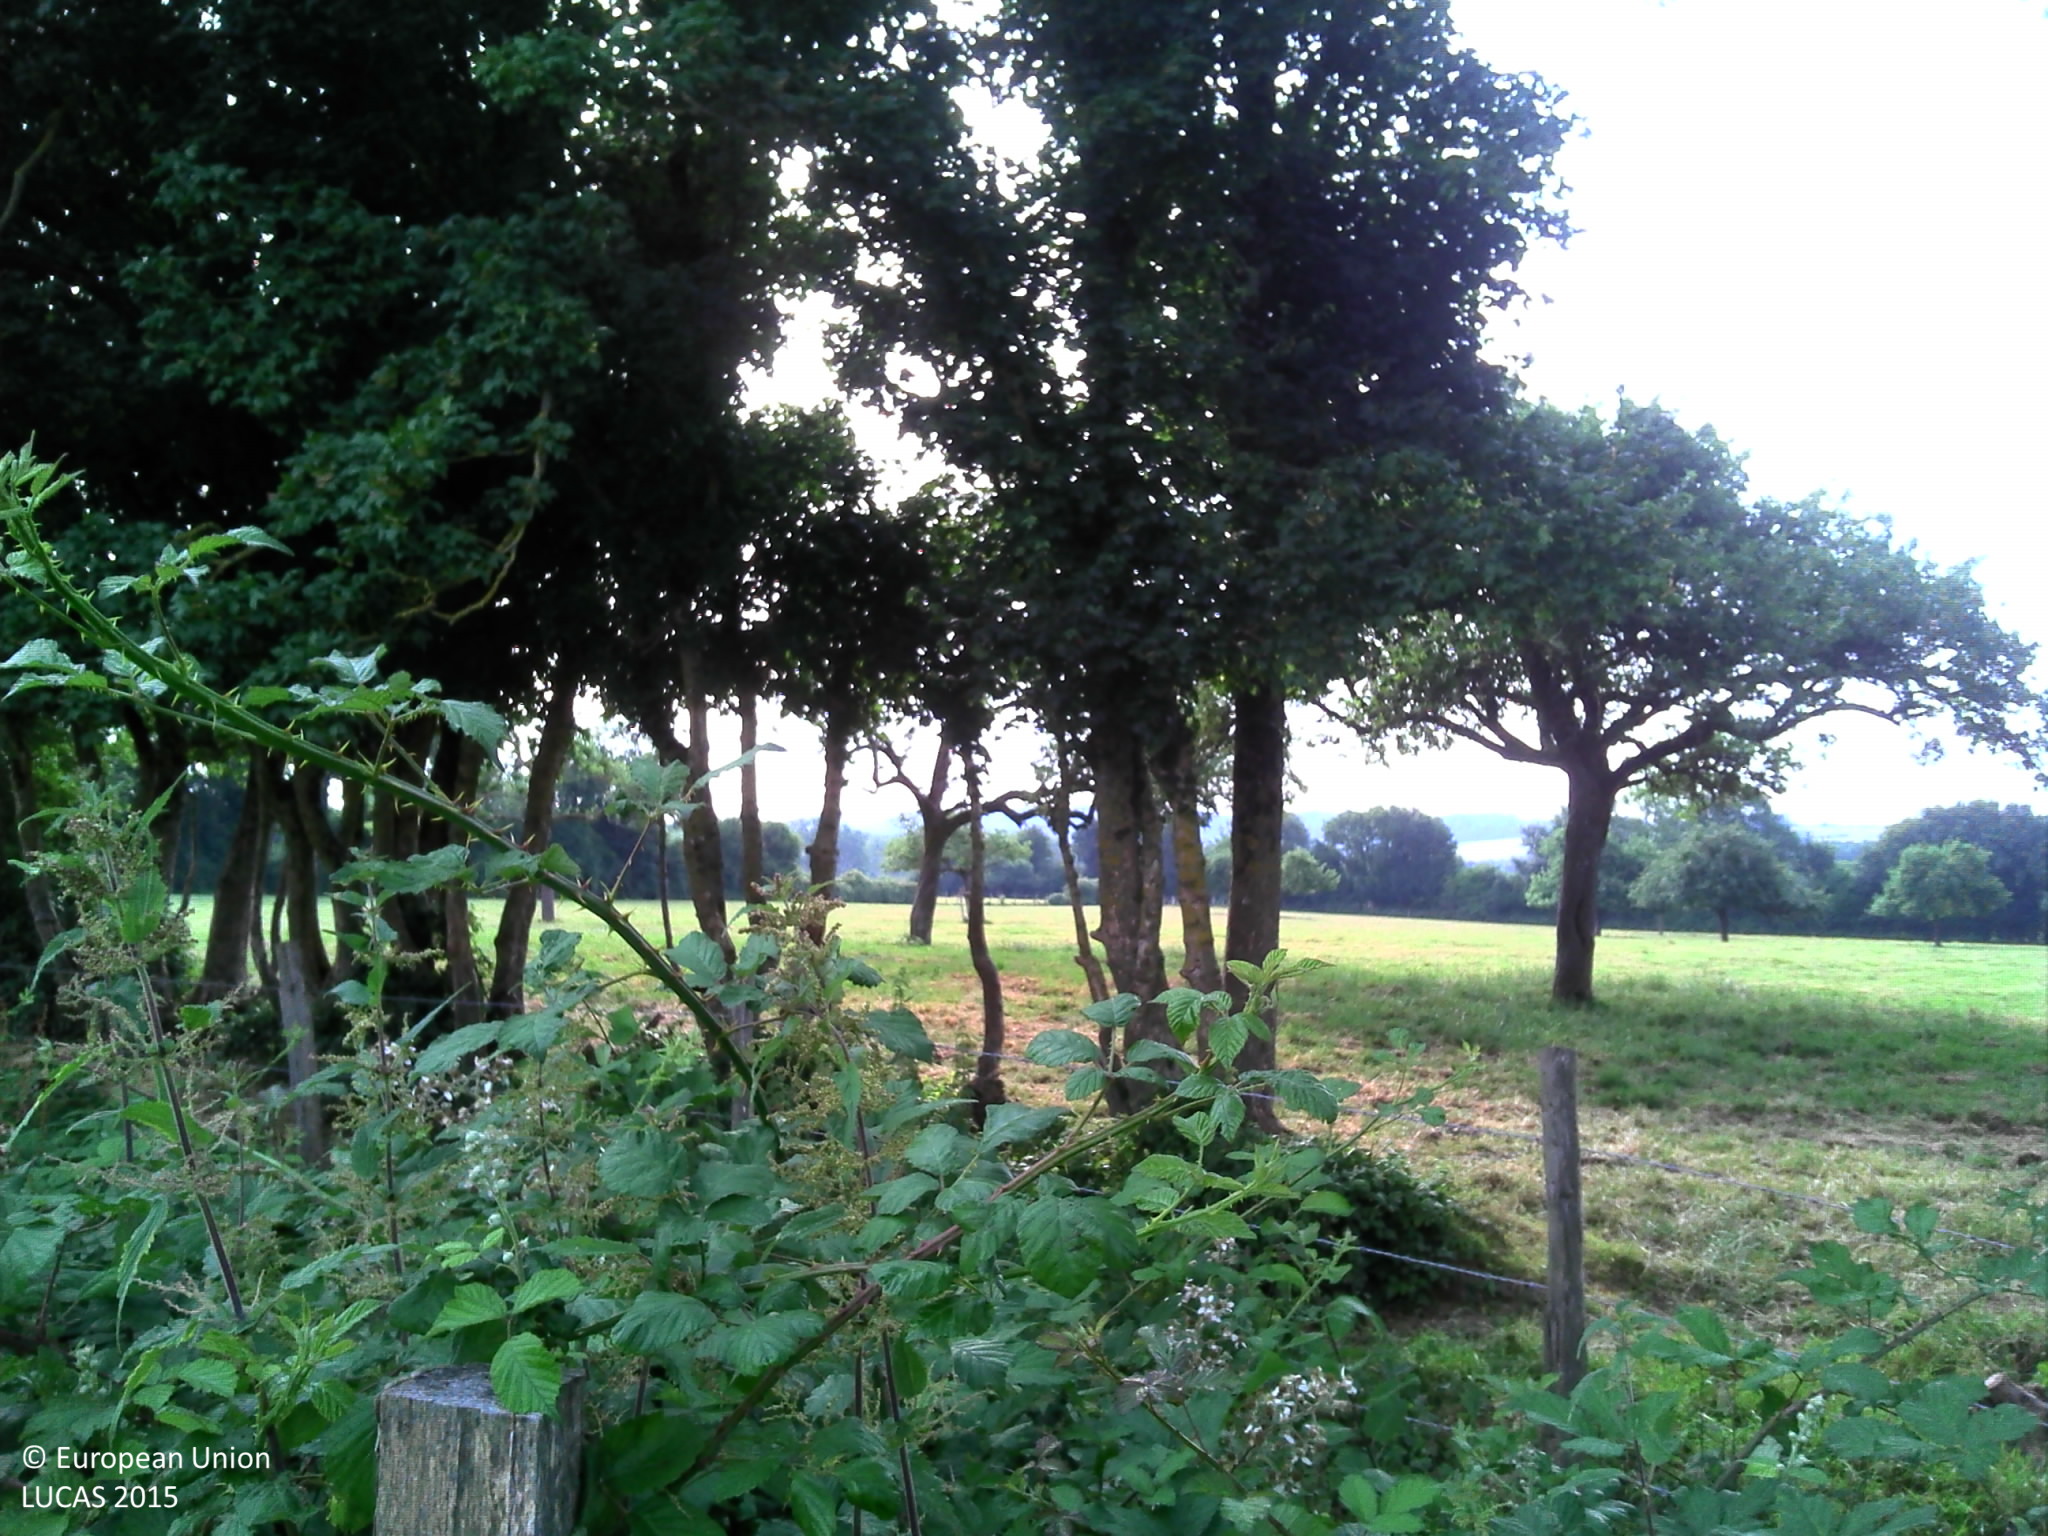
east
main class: Cropland
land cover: Rape and turnip rape
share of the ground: > 75 %
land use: Agriculture (excluding fallow land and kitchen gardens)
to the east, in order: Rape and turnip rape; Abandoned hedges; Fences; Grassland with sparse tree/shrub cover; Fences; Grassland with sparse tree/shrub cover; Fences; Lines of trees; Common wheat
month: June
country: FR
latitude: 48.3623
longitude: 0.1599
